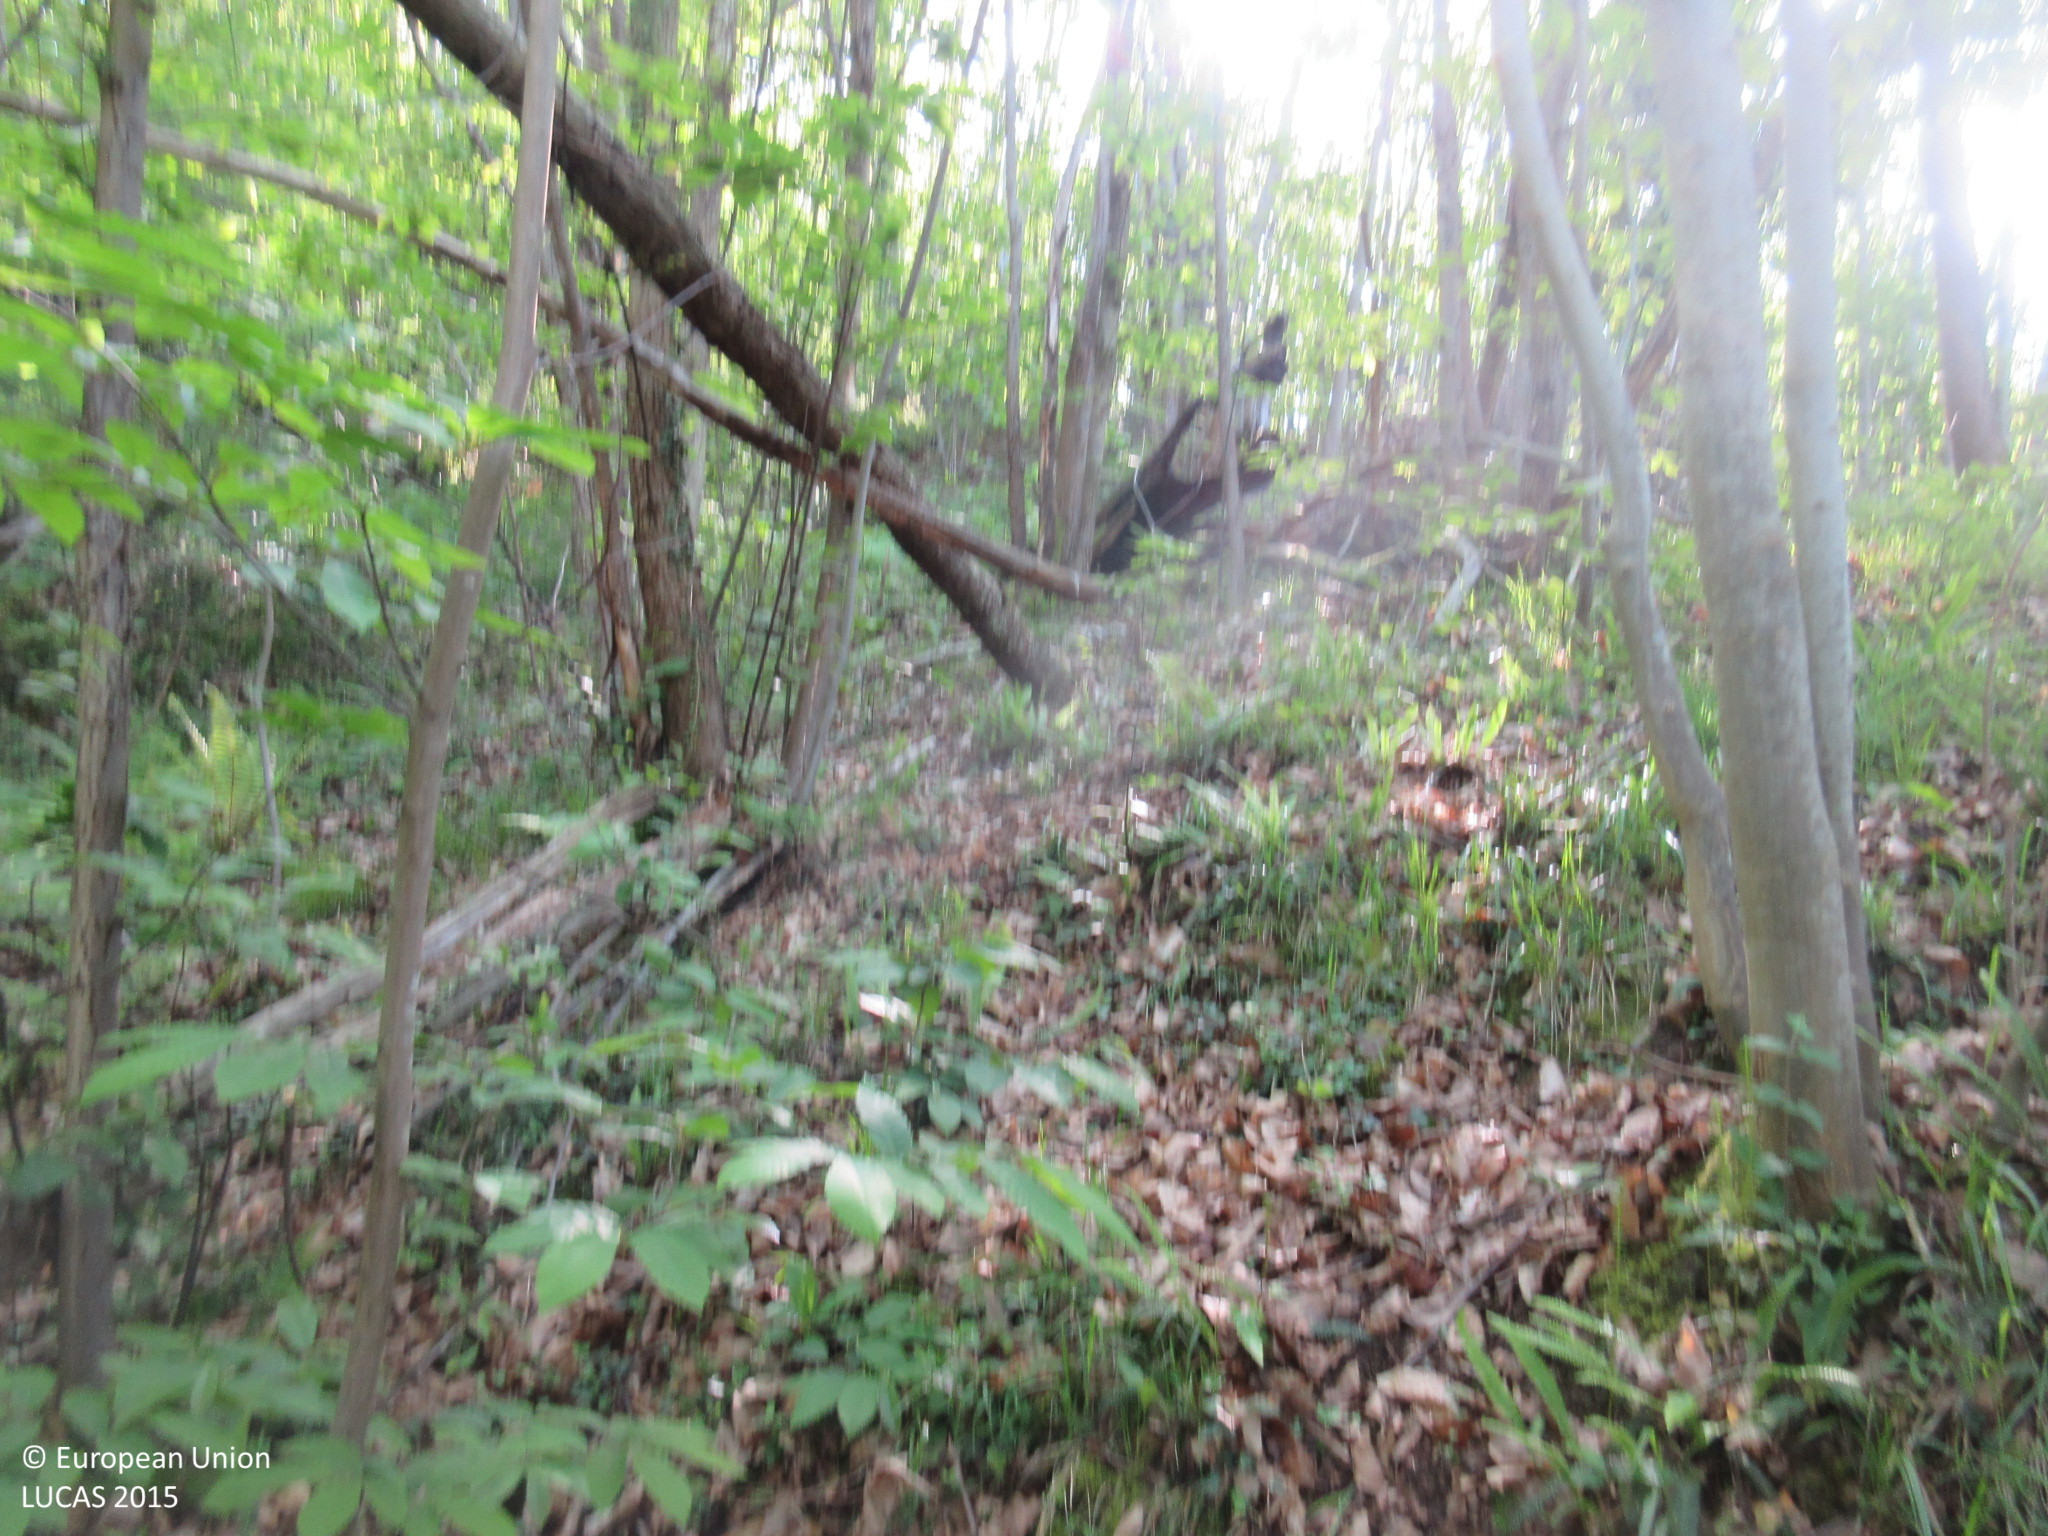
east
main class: Woodland
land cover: Broadleaved woodland
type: thermophilous deciduous forest
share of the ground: > 75 %
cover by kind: broadleaved forest trees 95 %, shrubs 5 %
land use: Forestry
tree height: > 5 m
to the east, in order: Broadleaved woodland; Fences; Apple fruit; Fences; Tracks; Broadleaved woodland
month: May
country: ES
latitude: 43.2276
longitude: -5.5311
